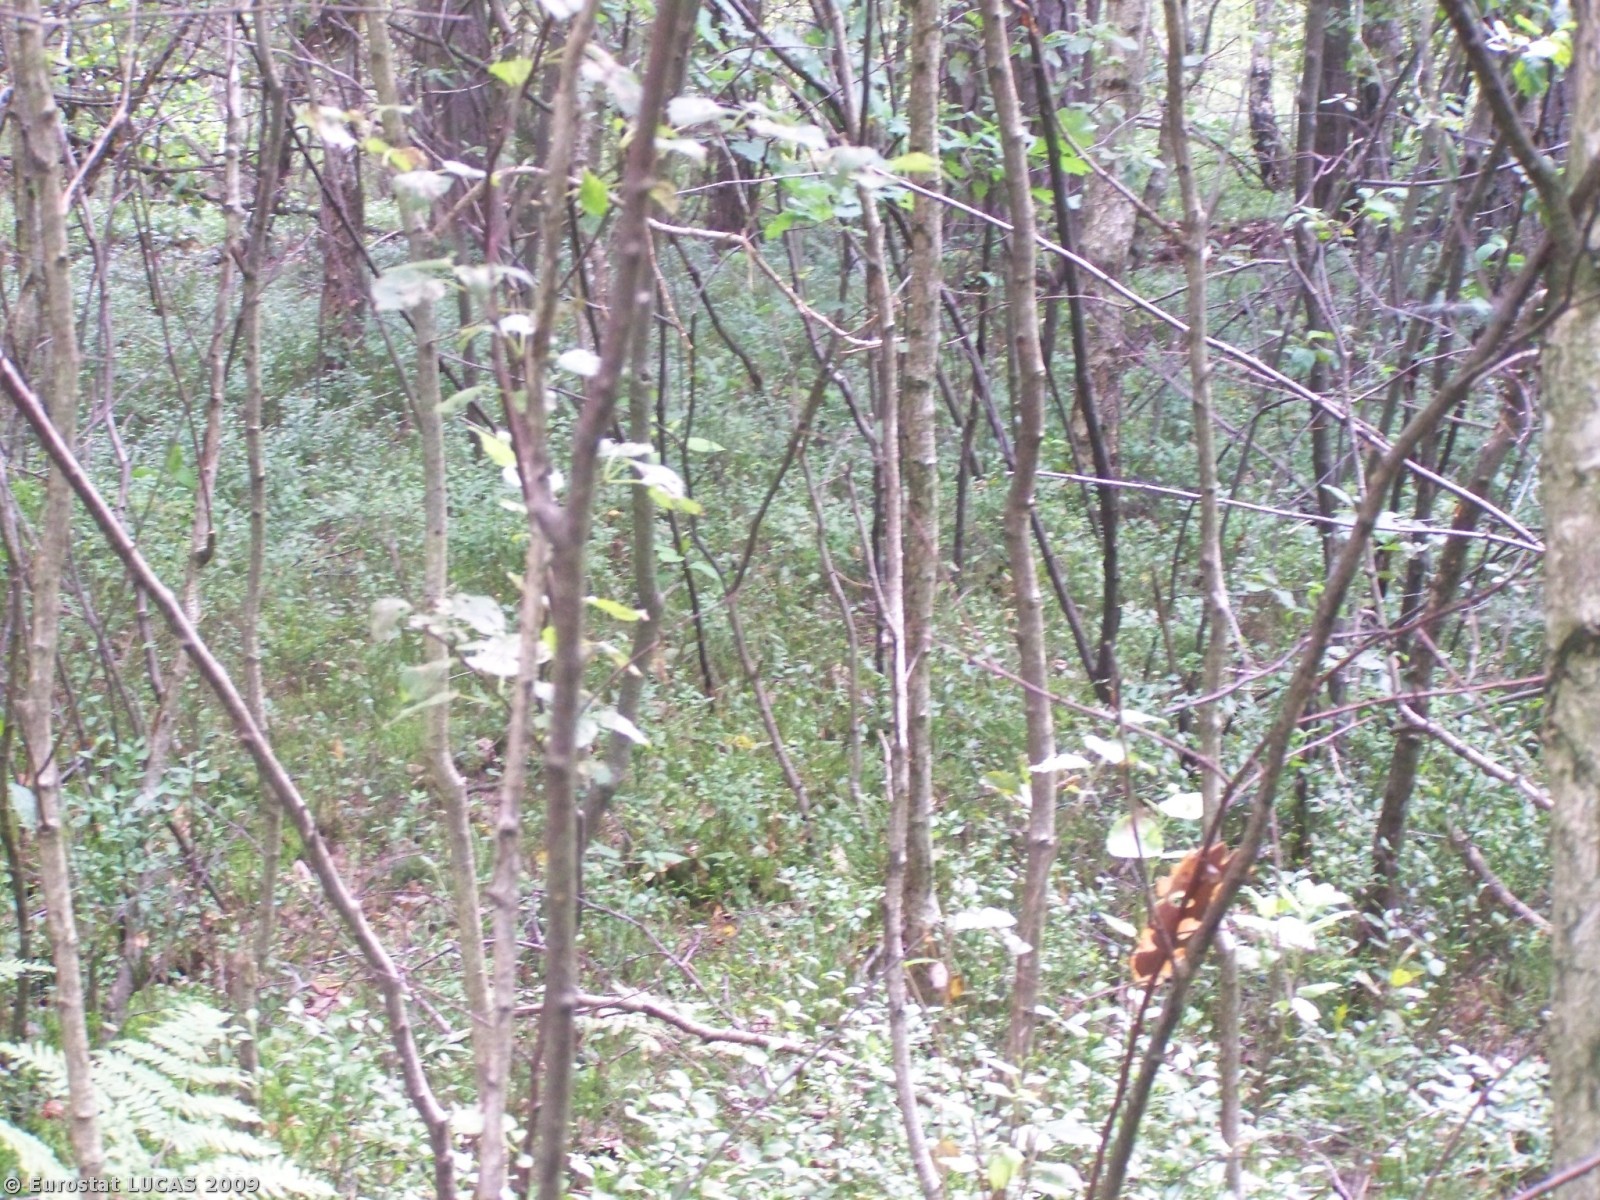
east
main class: Woodland
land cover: Mixed woodland
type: hemiboreal forest and nemoral coniferous forest and mixed broadleaved-coniferous forest
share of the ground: > 75 %
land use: Forestry
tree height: > 5 m
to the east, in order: Mixed woodland; Ditches and canals; Broadleaved woodland; Coniferous woodland; Tracks; Coniferous woodland; Mixed woodland; Grassland with sparse tree/shrub cover
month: July
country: PL
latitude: 52.1299
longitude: 21.6374
